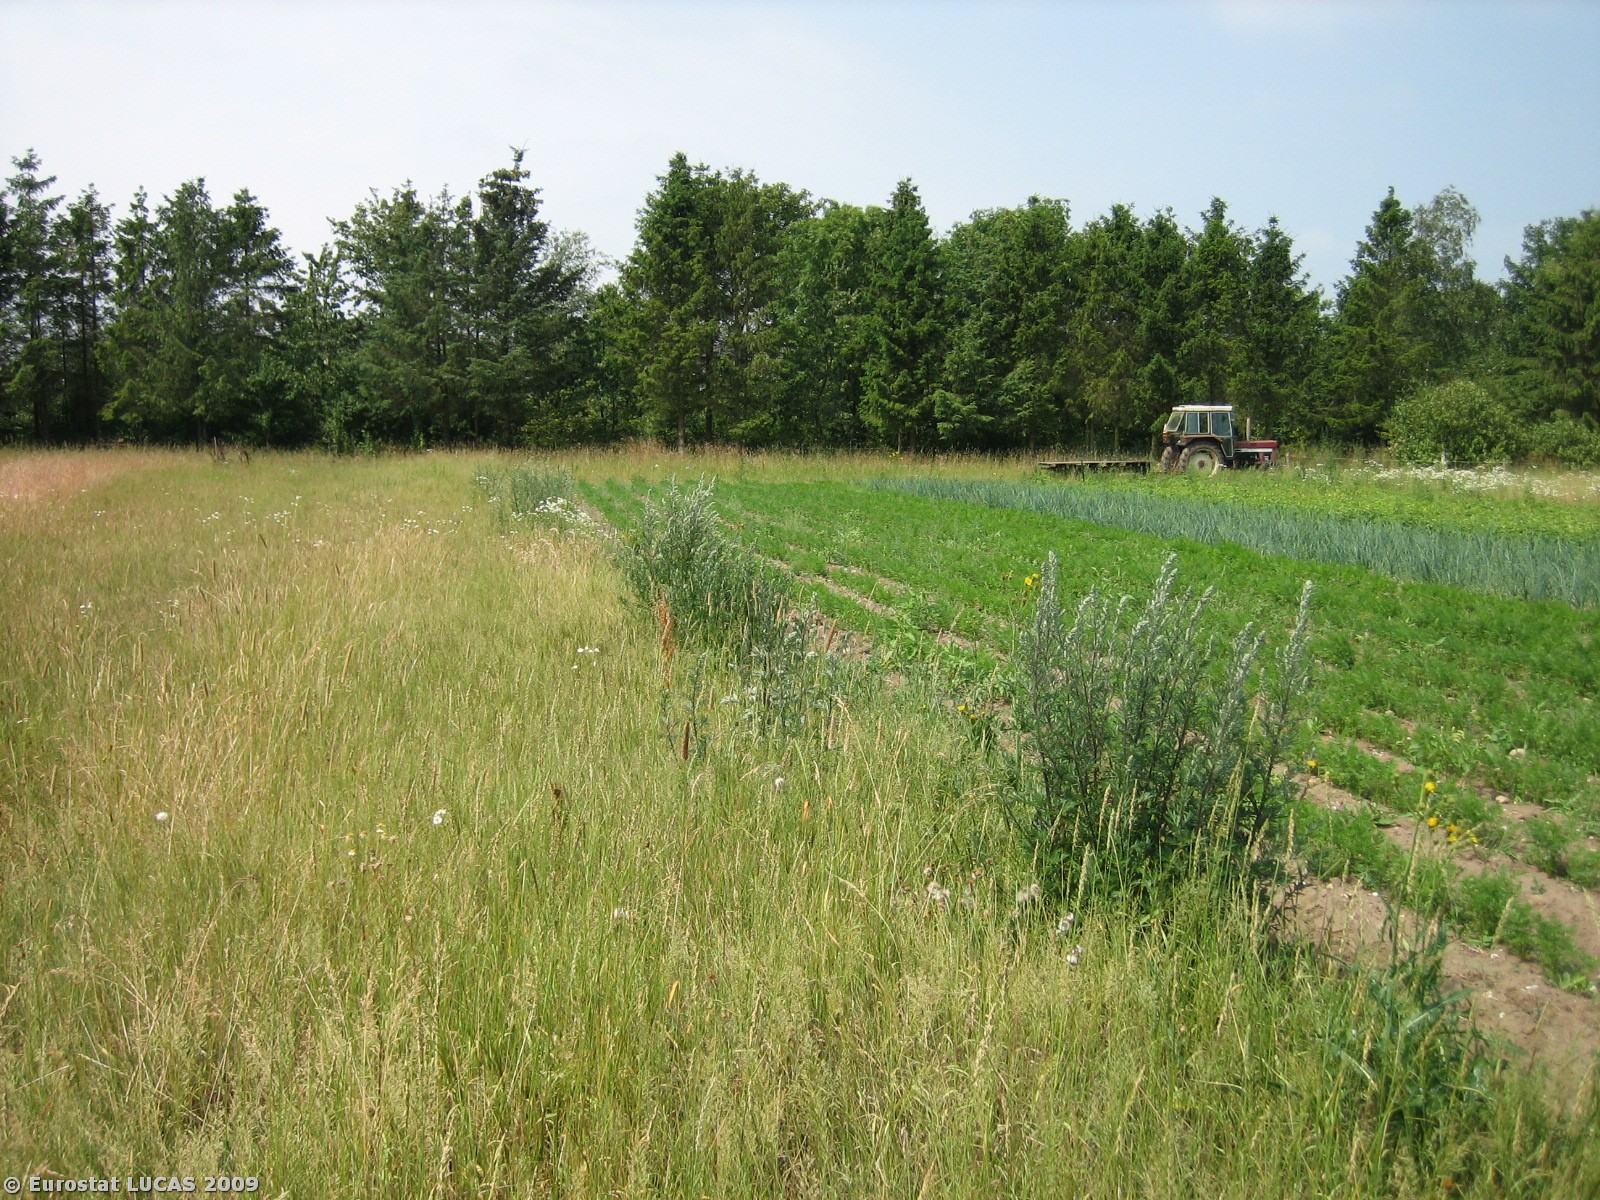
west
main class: Grassland
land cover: Grassland without tree/shrub cover
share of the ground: > 75 %
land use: Agriculture (excluding fallow land and kitchen gardens)
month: July
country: DK
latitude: 55.4985
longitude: 8.7506
